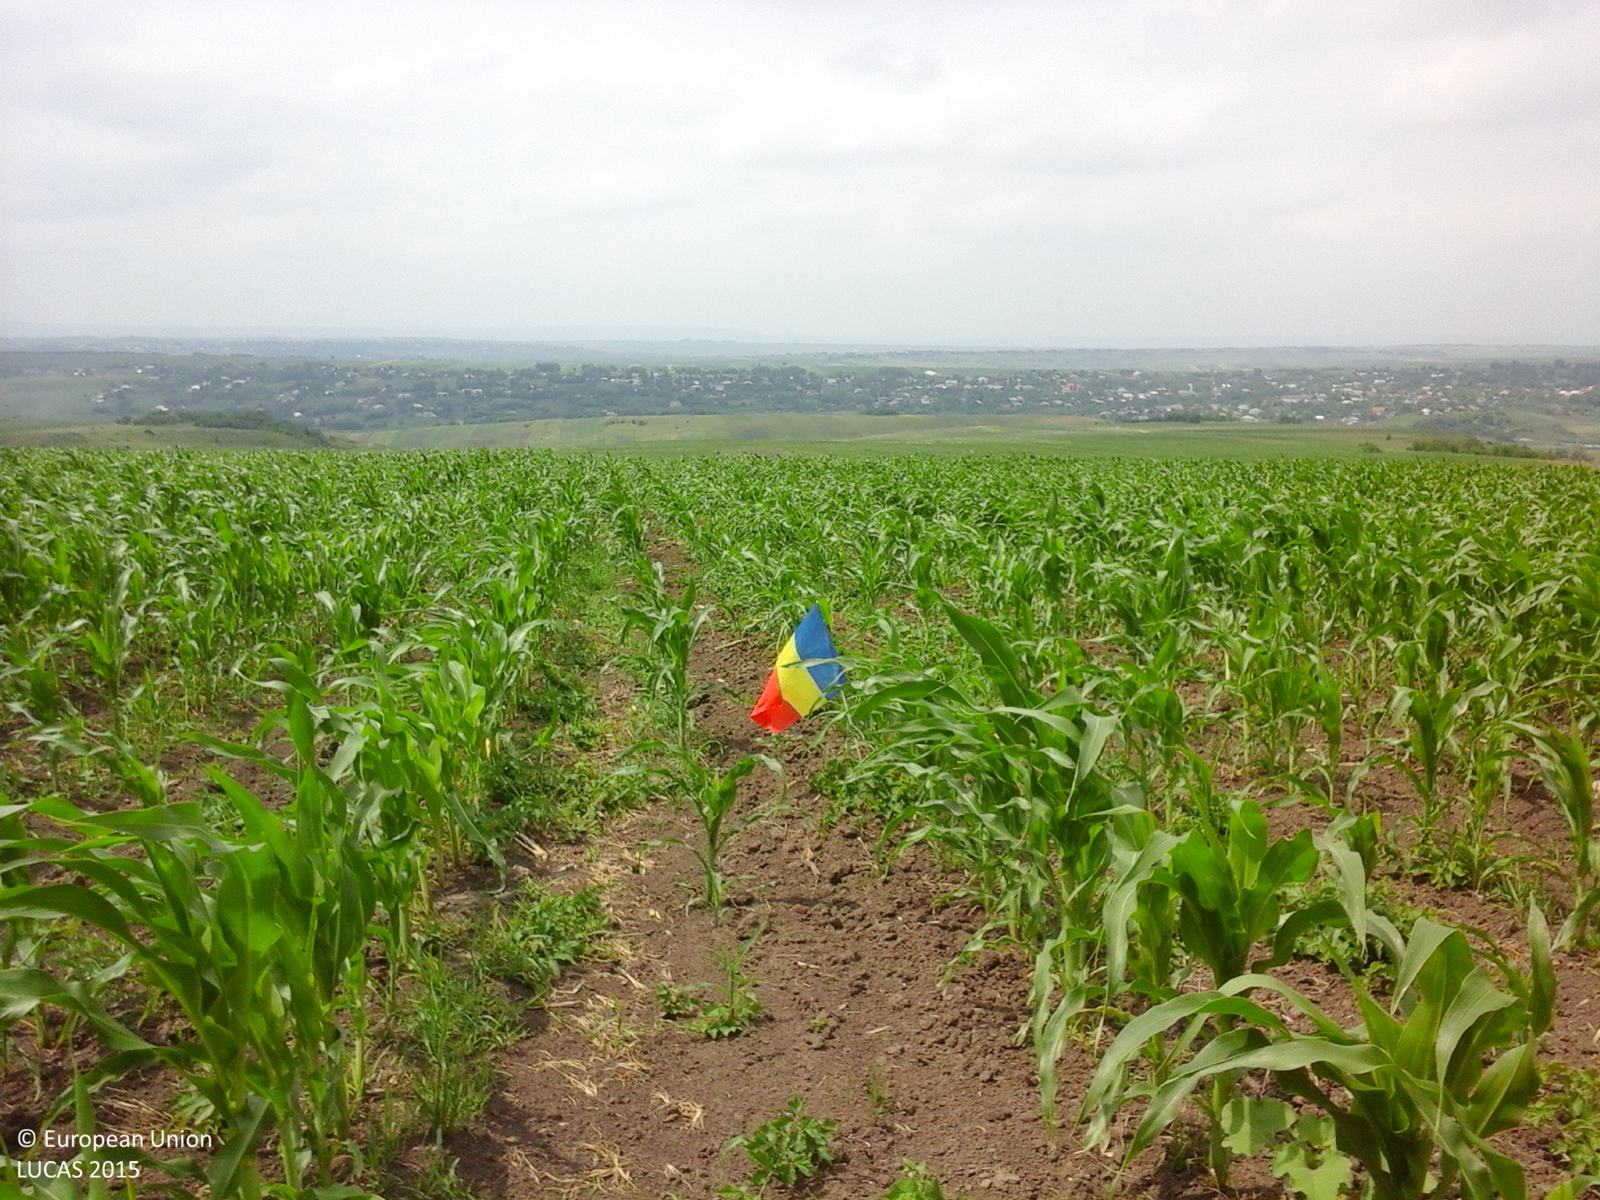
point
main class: Cropland
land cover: Maize
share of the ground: 50 - 75 %
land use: Agriculture (excluding fallow land and kitchen gardens)
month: June
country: RO
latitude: 47.8628
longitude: 26.6577
